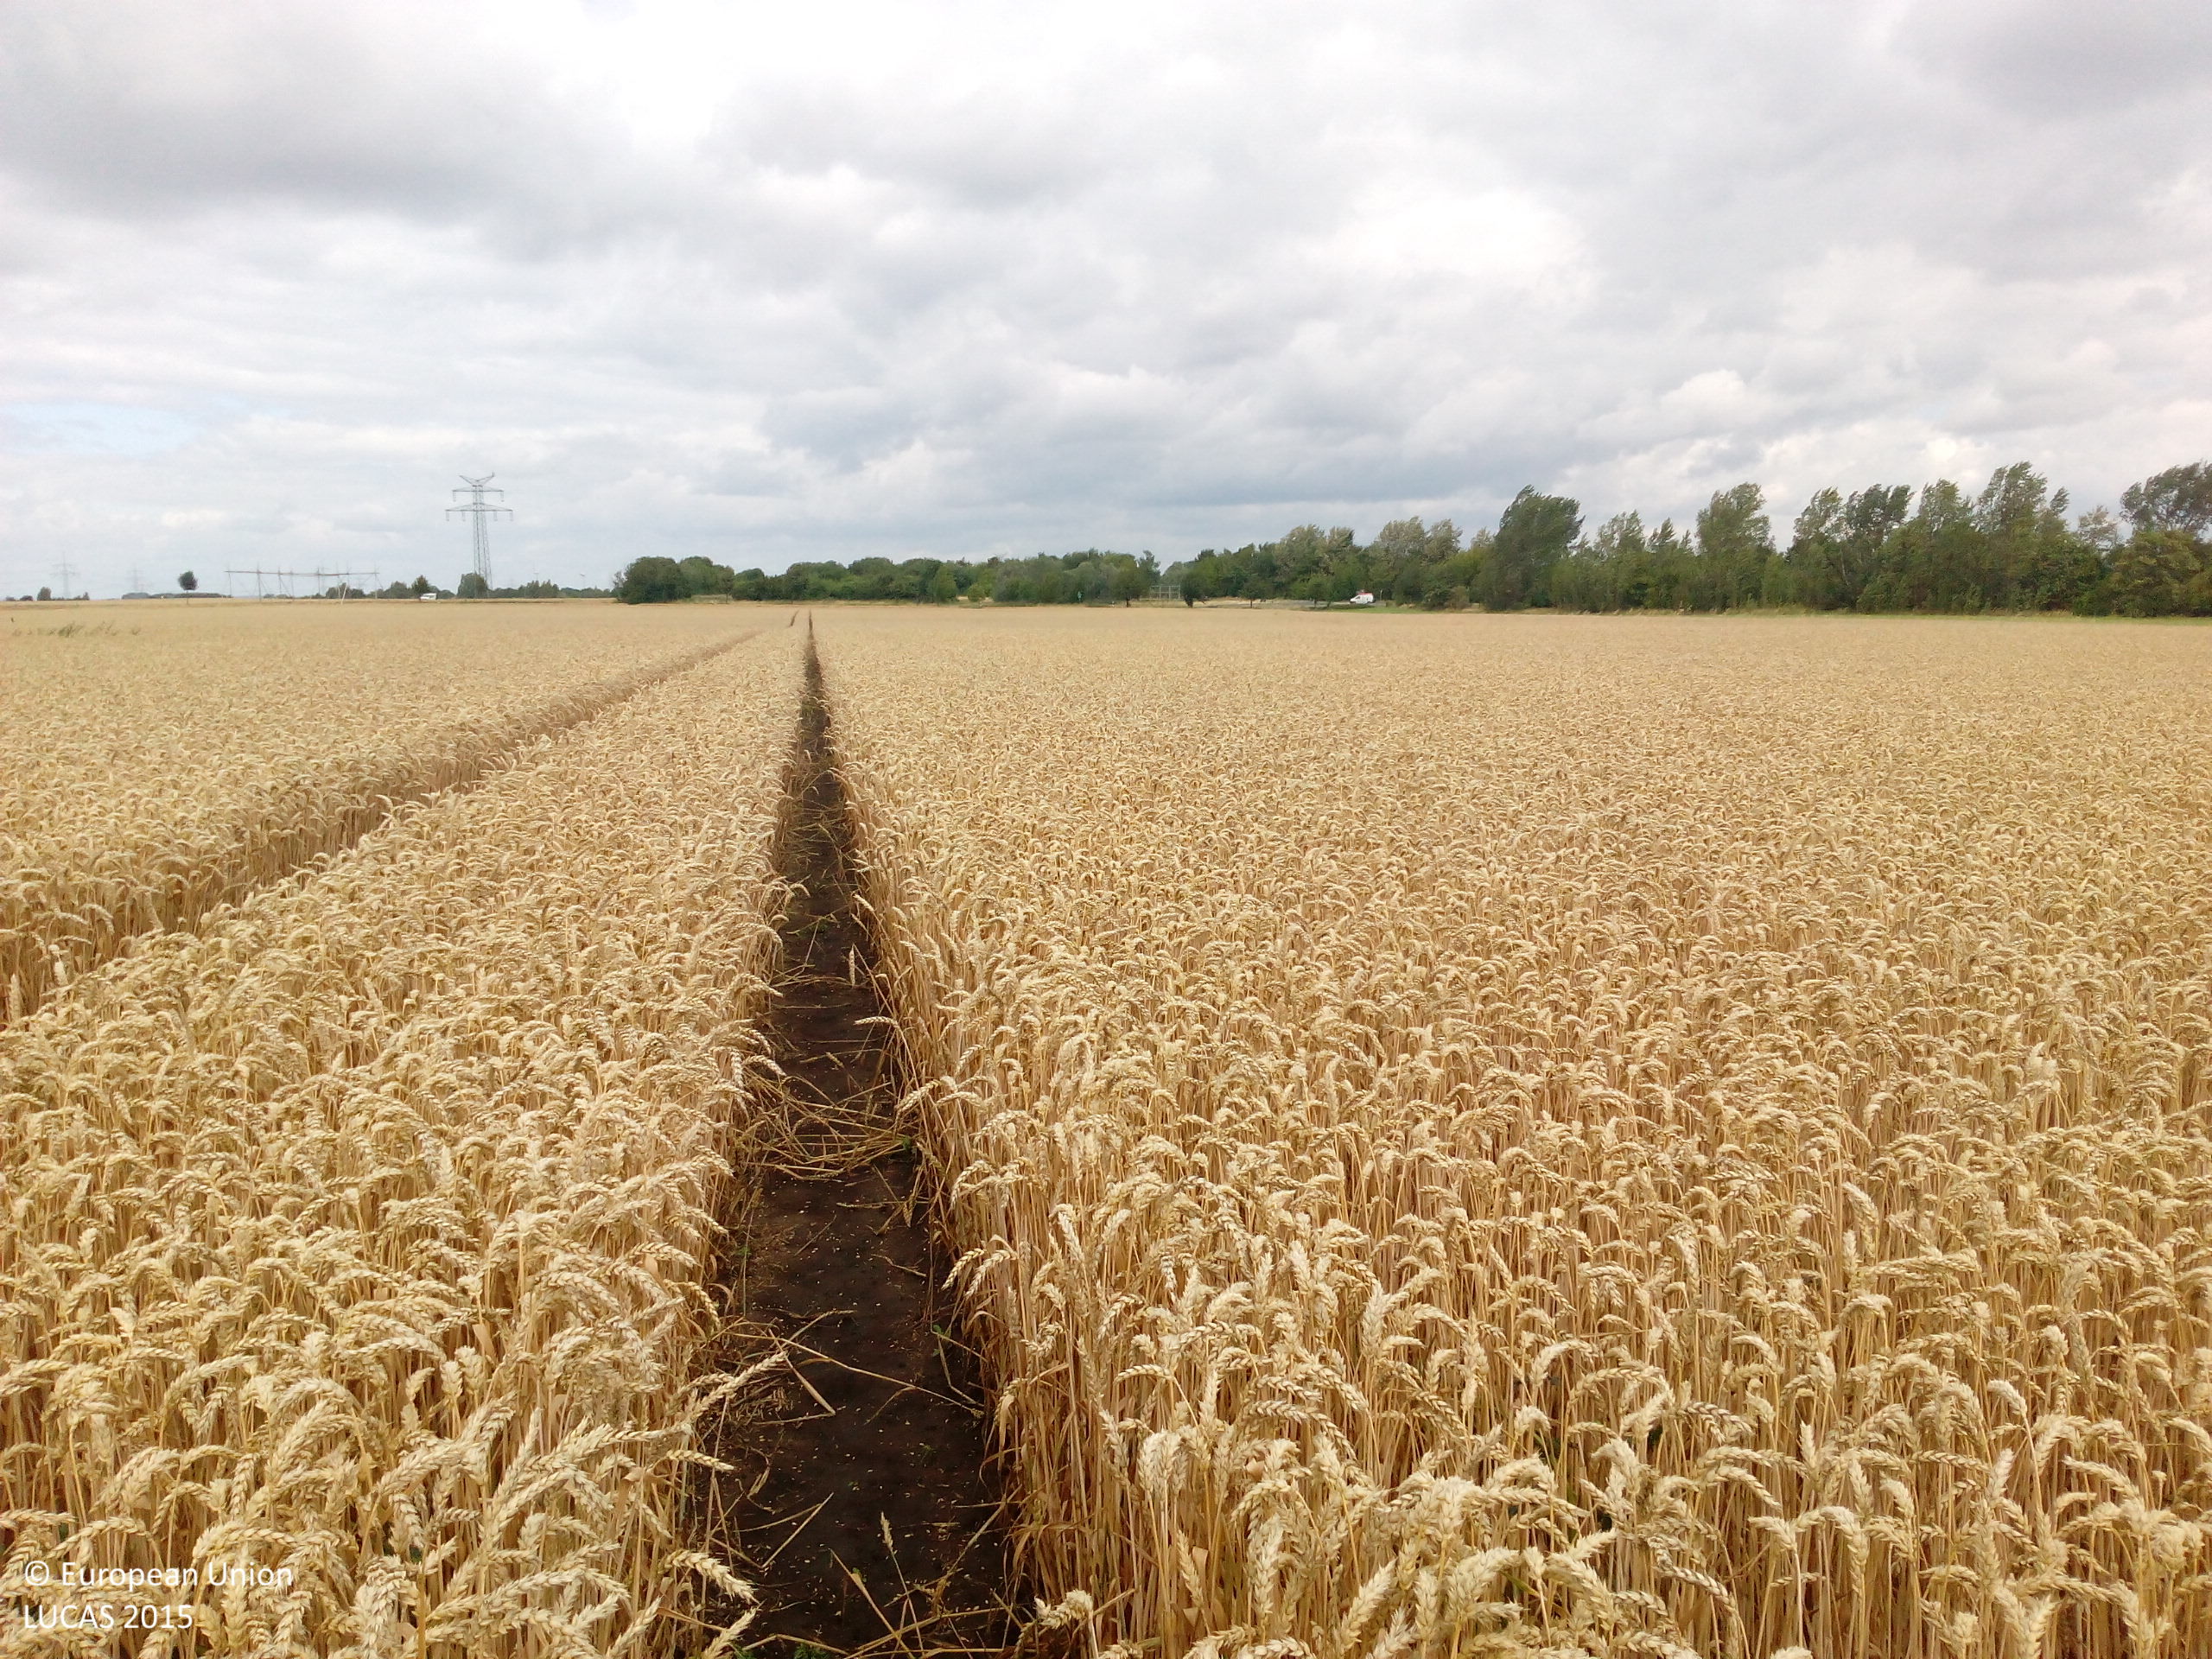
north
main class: Cropland
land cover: Common wheat
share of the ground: > 75 %
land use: Agriculture (excluding fallow land and kitchen gardens)
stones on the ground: < 10 %
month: July
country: DE
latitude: 52.1874
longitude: 11.5647
